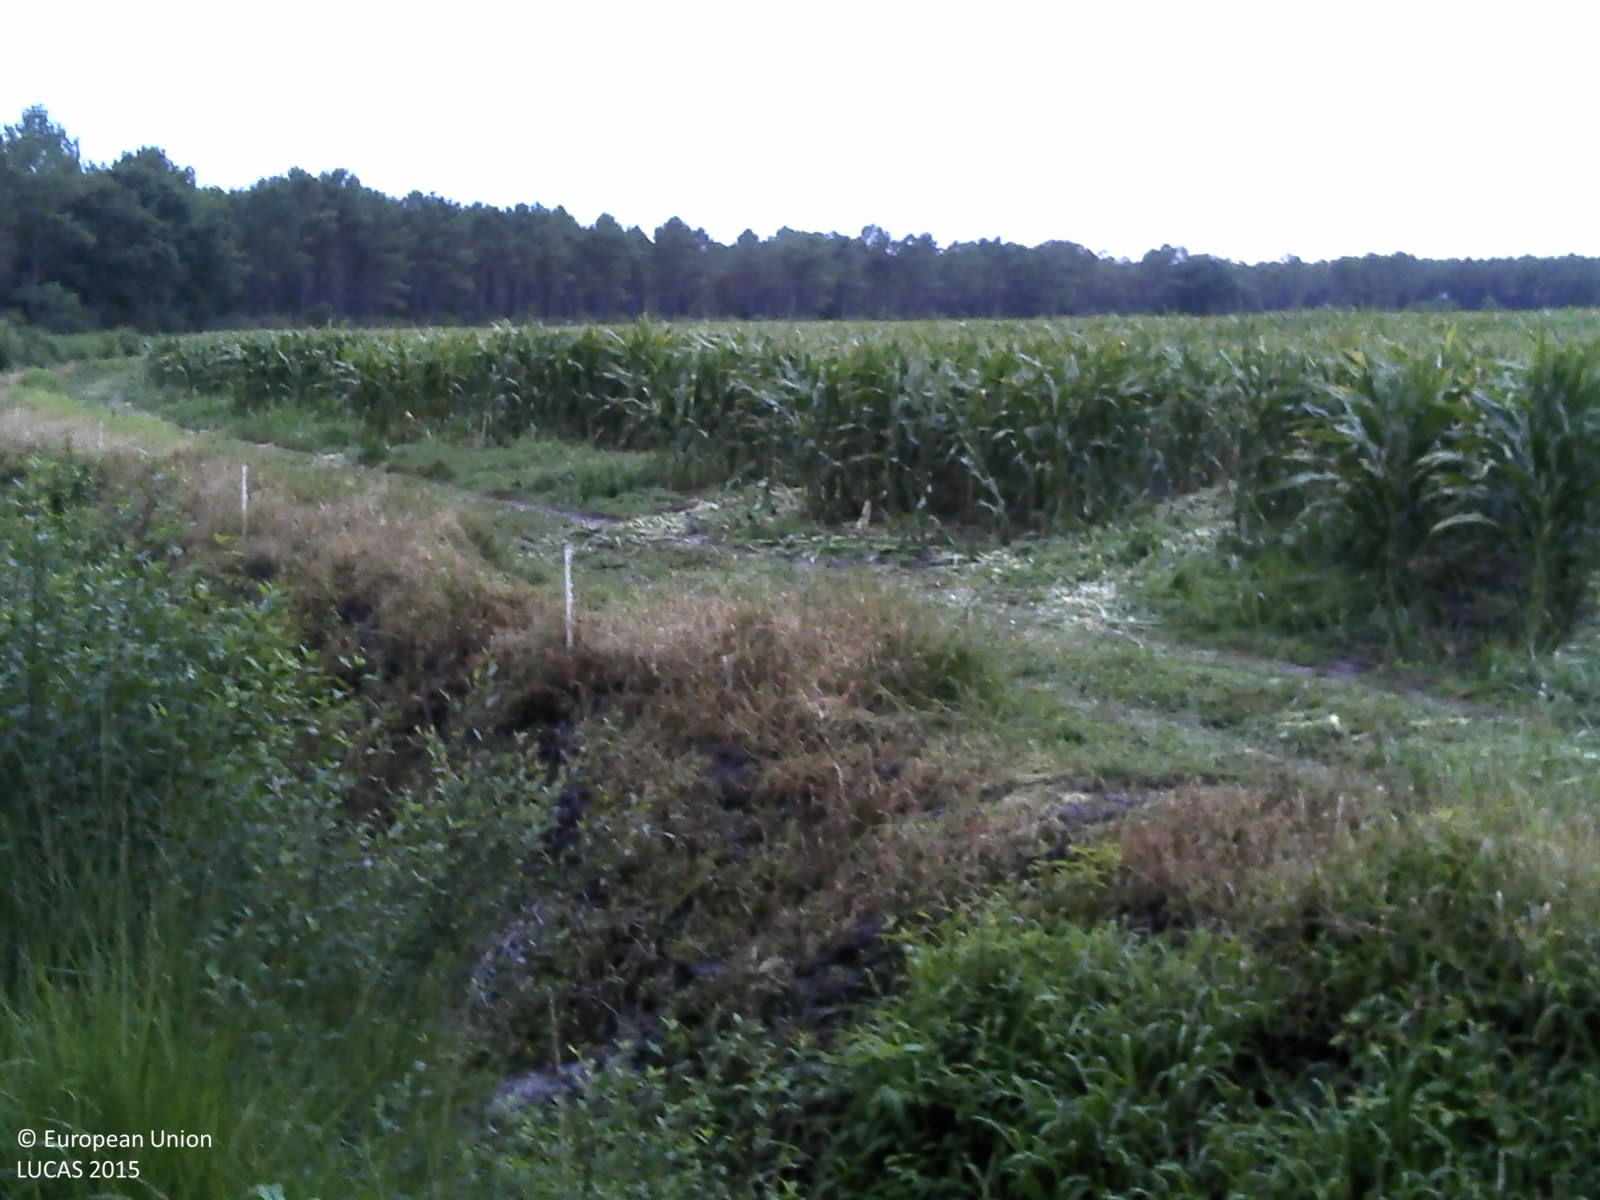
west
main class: Cropland
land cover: Maize
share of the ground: > 75 %
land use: Agriculture (excluding fallow land and kitchen gardens)
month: August
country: FR
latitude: 44.7462
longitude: -0.9978
